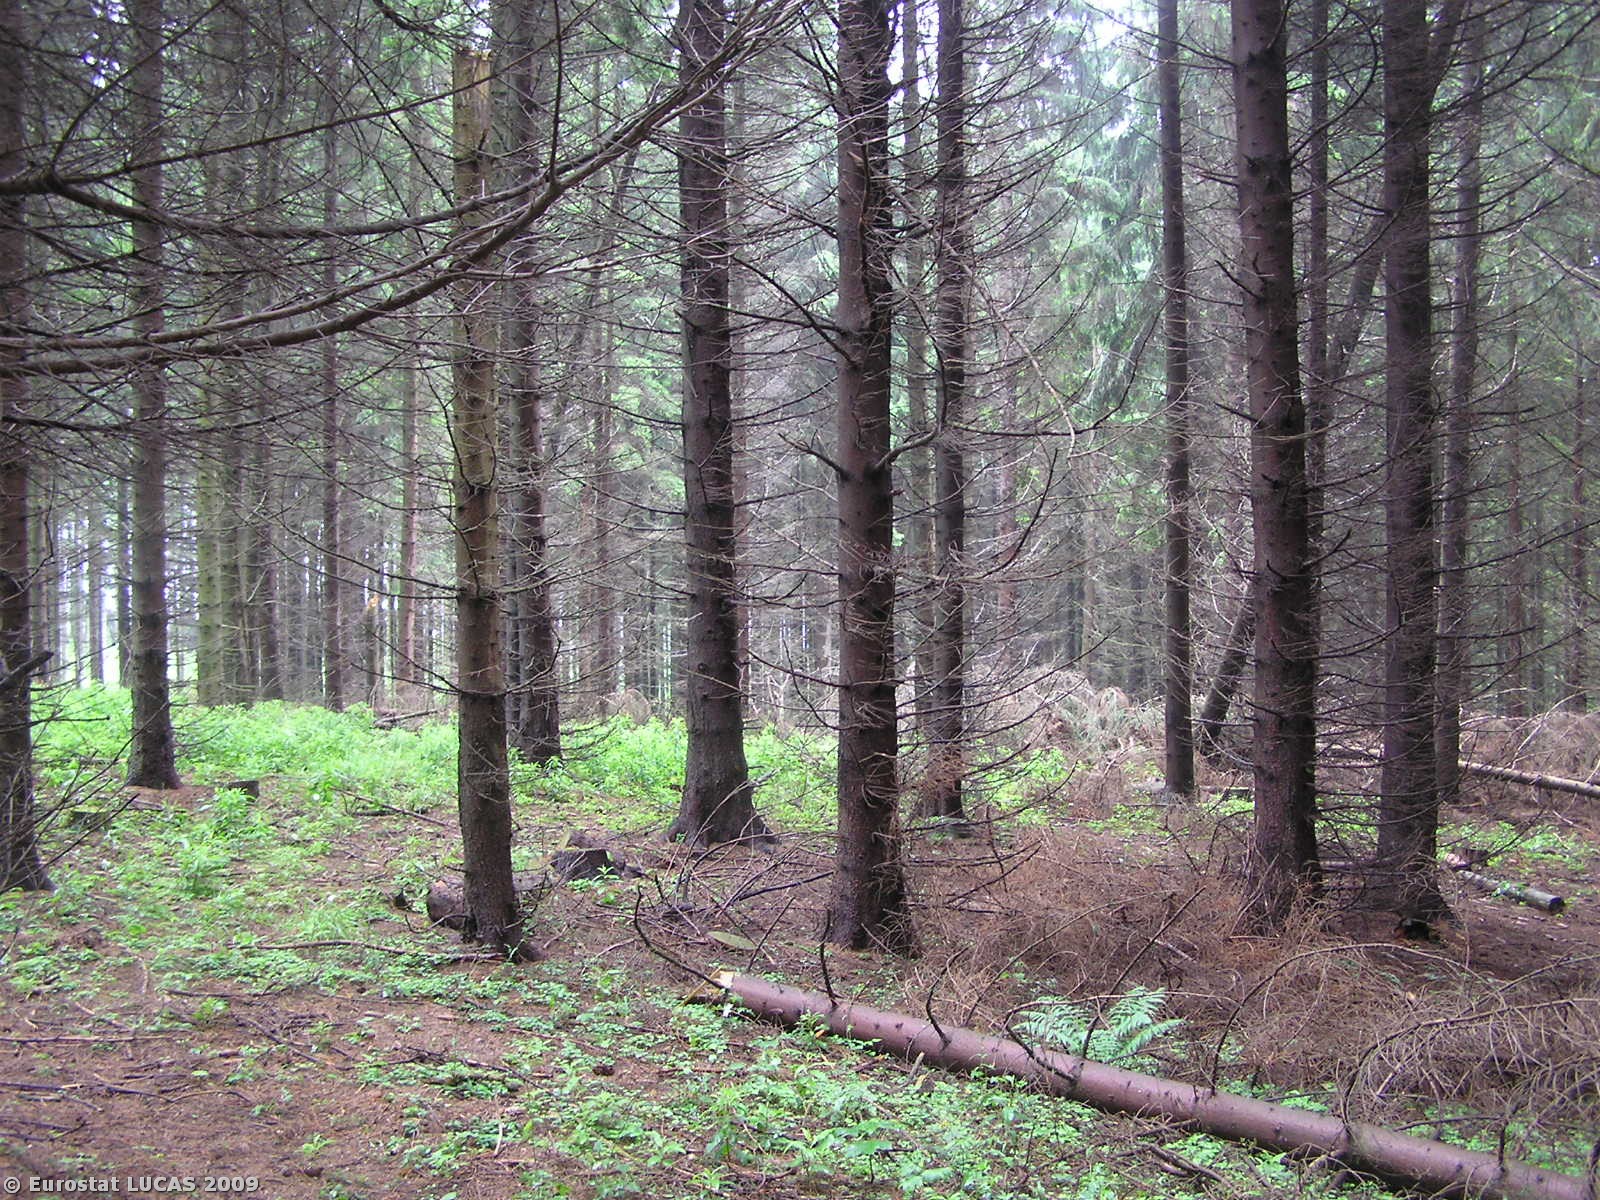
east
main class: Woodland
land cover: Coniferous woodland
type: hemiboreal forest and nemoral coniferous forest and mixed broadleaved-coniferous forest
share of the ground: > 75 %
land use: Forestry
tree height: > 5 m
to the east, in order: Coniferous woodland; Mixed woodland; Tracks; Mixed woodland; Tracks; Broadleaved woodland
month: May
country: CZ
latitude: 50.1395
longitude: 17.4418
